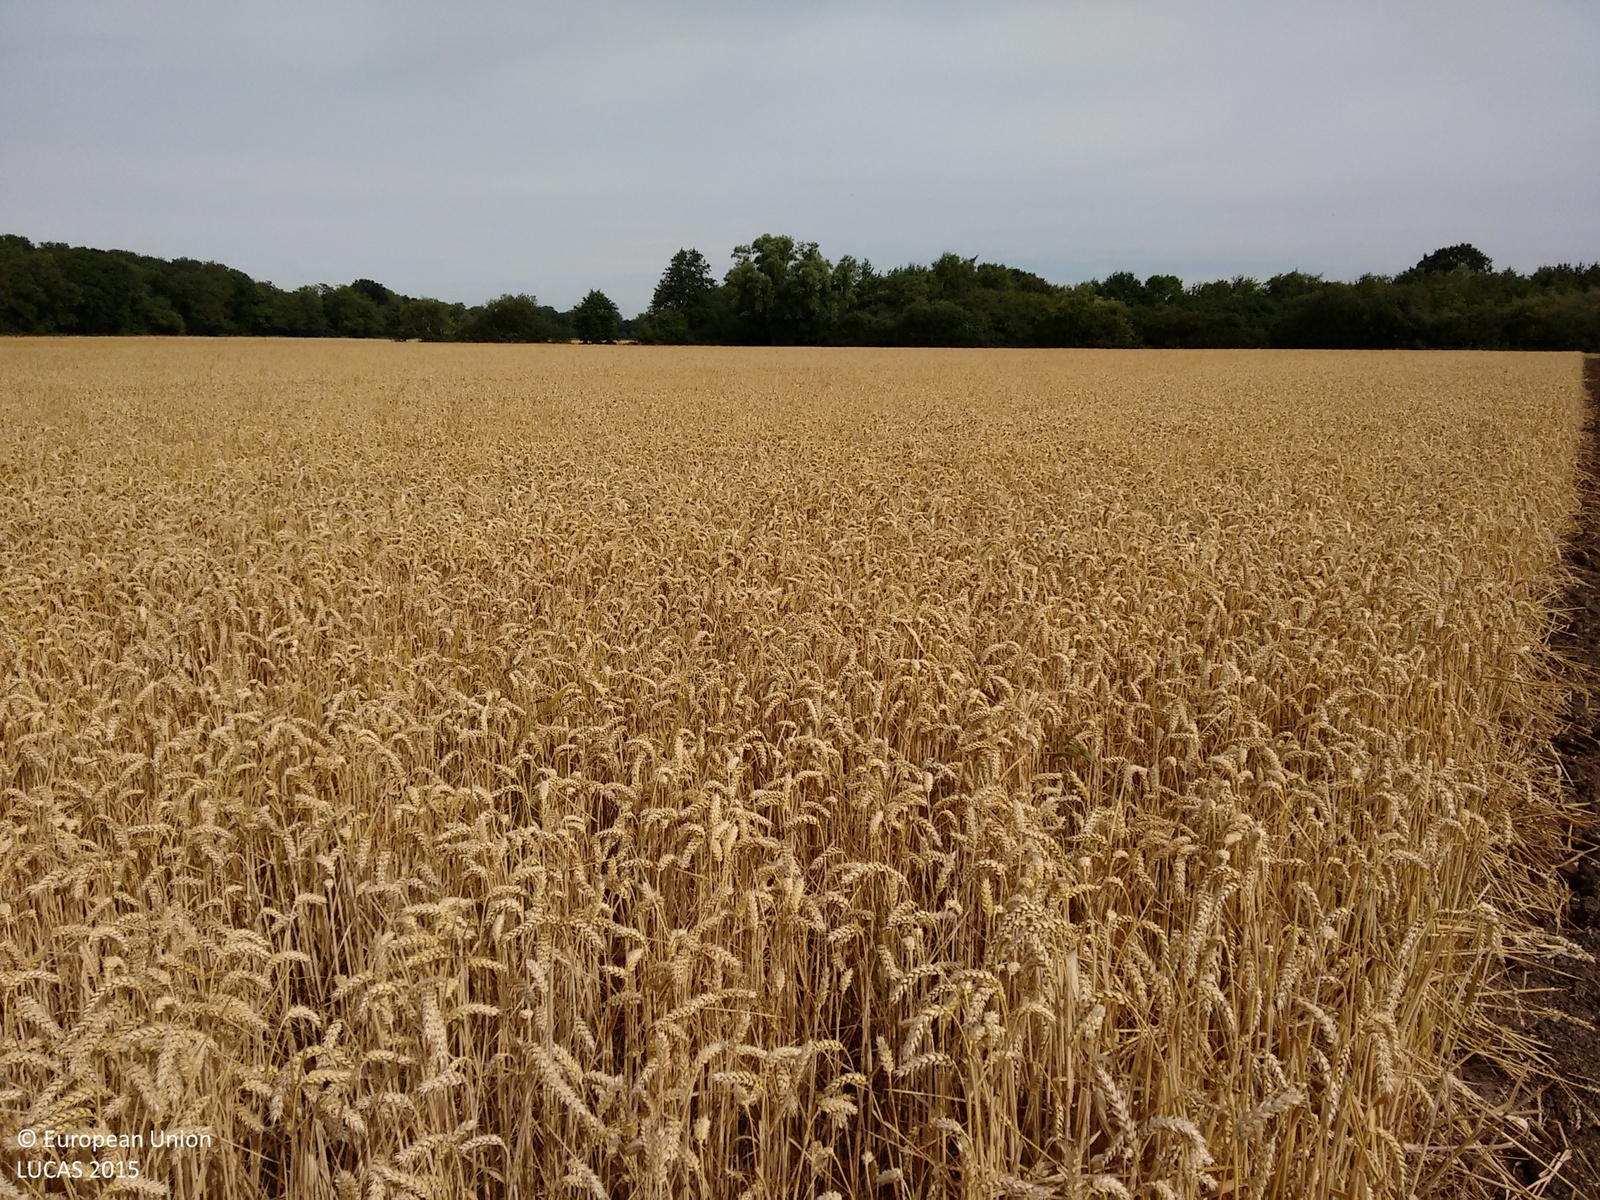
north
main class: Cropland
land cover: Common wheat
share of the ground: > 75 %
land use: Agriculture (excluding fallow land and kitchen gardens)
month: August
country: GB
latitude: 52.5715
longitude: 0.4553
